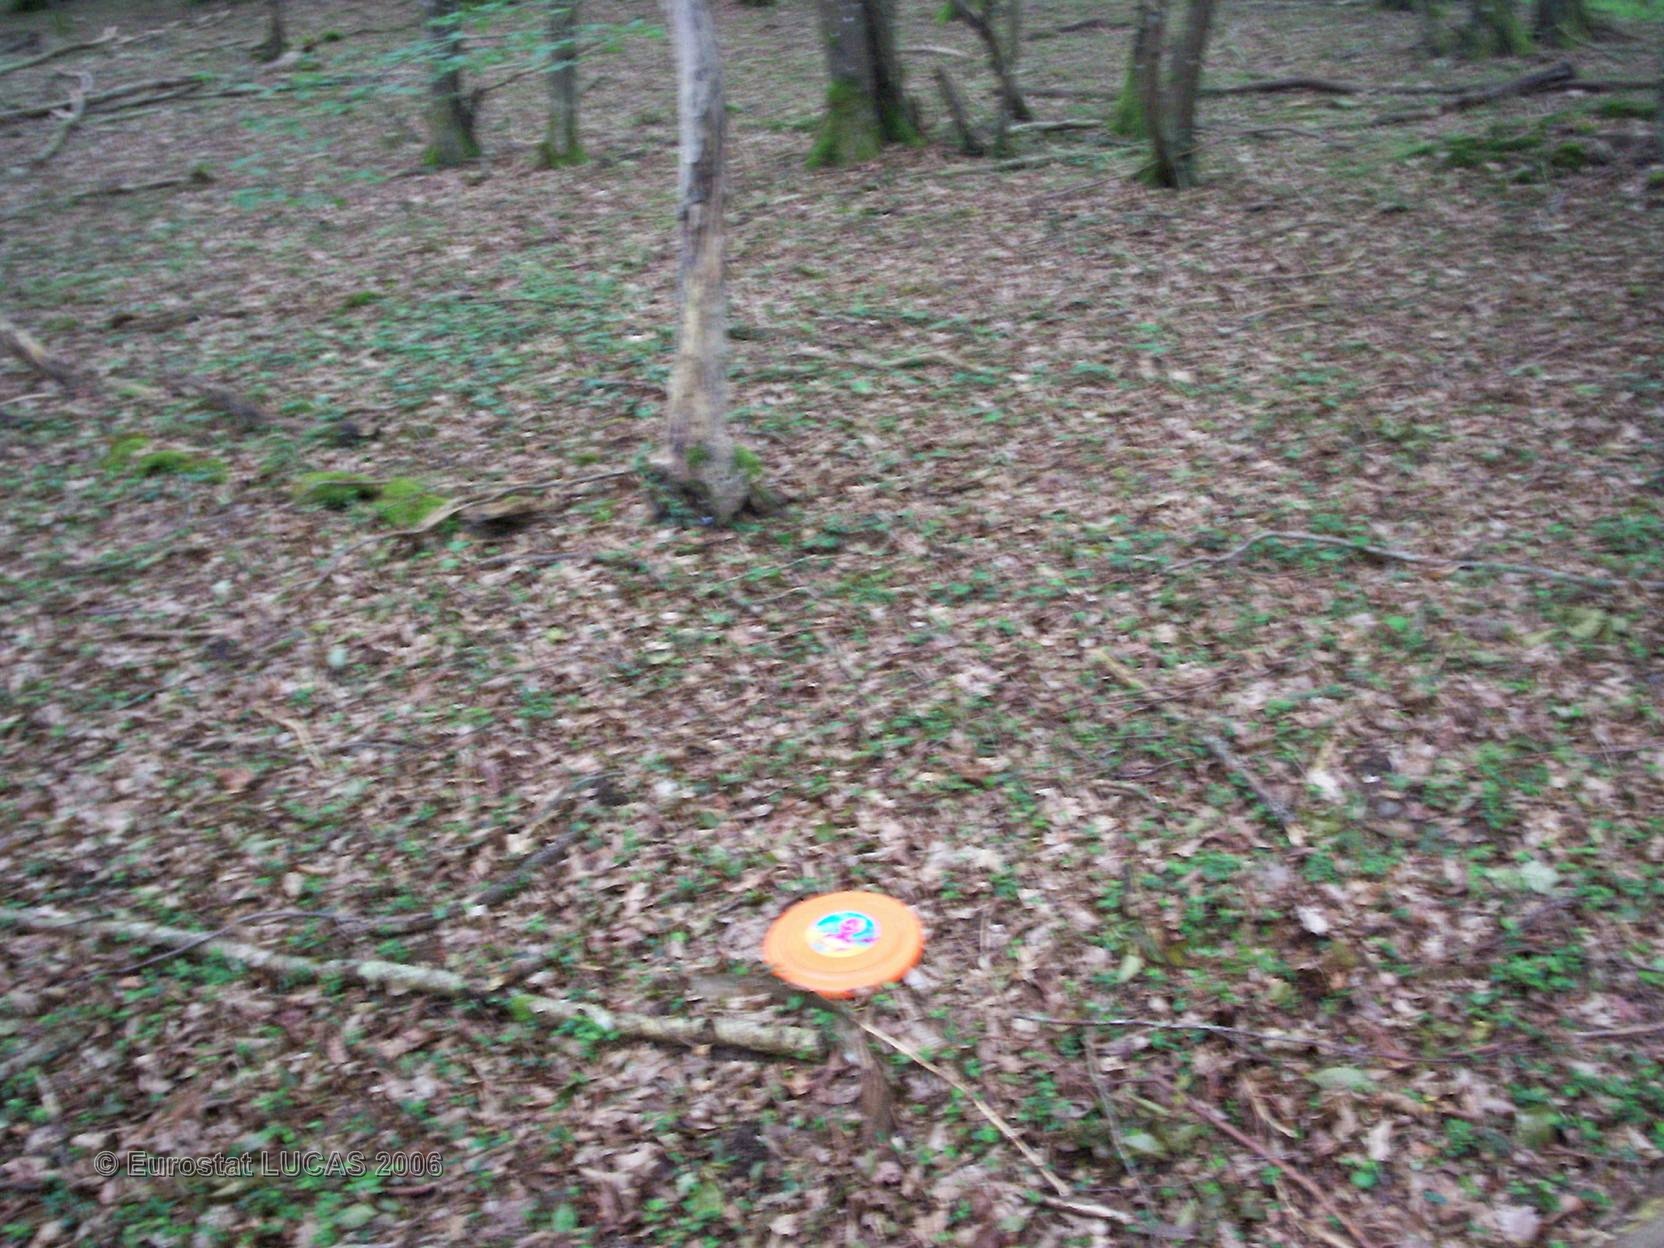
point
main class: Woodland
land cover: Broadleaved forest
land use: Forestry
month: May
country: FR
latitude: 46.8827
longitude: 3.0281
